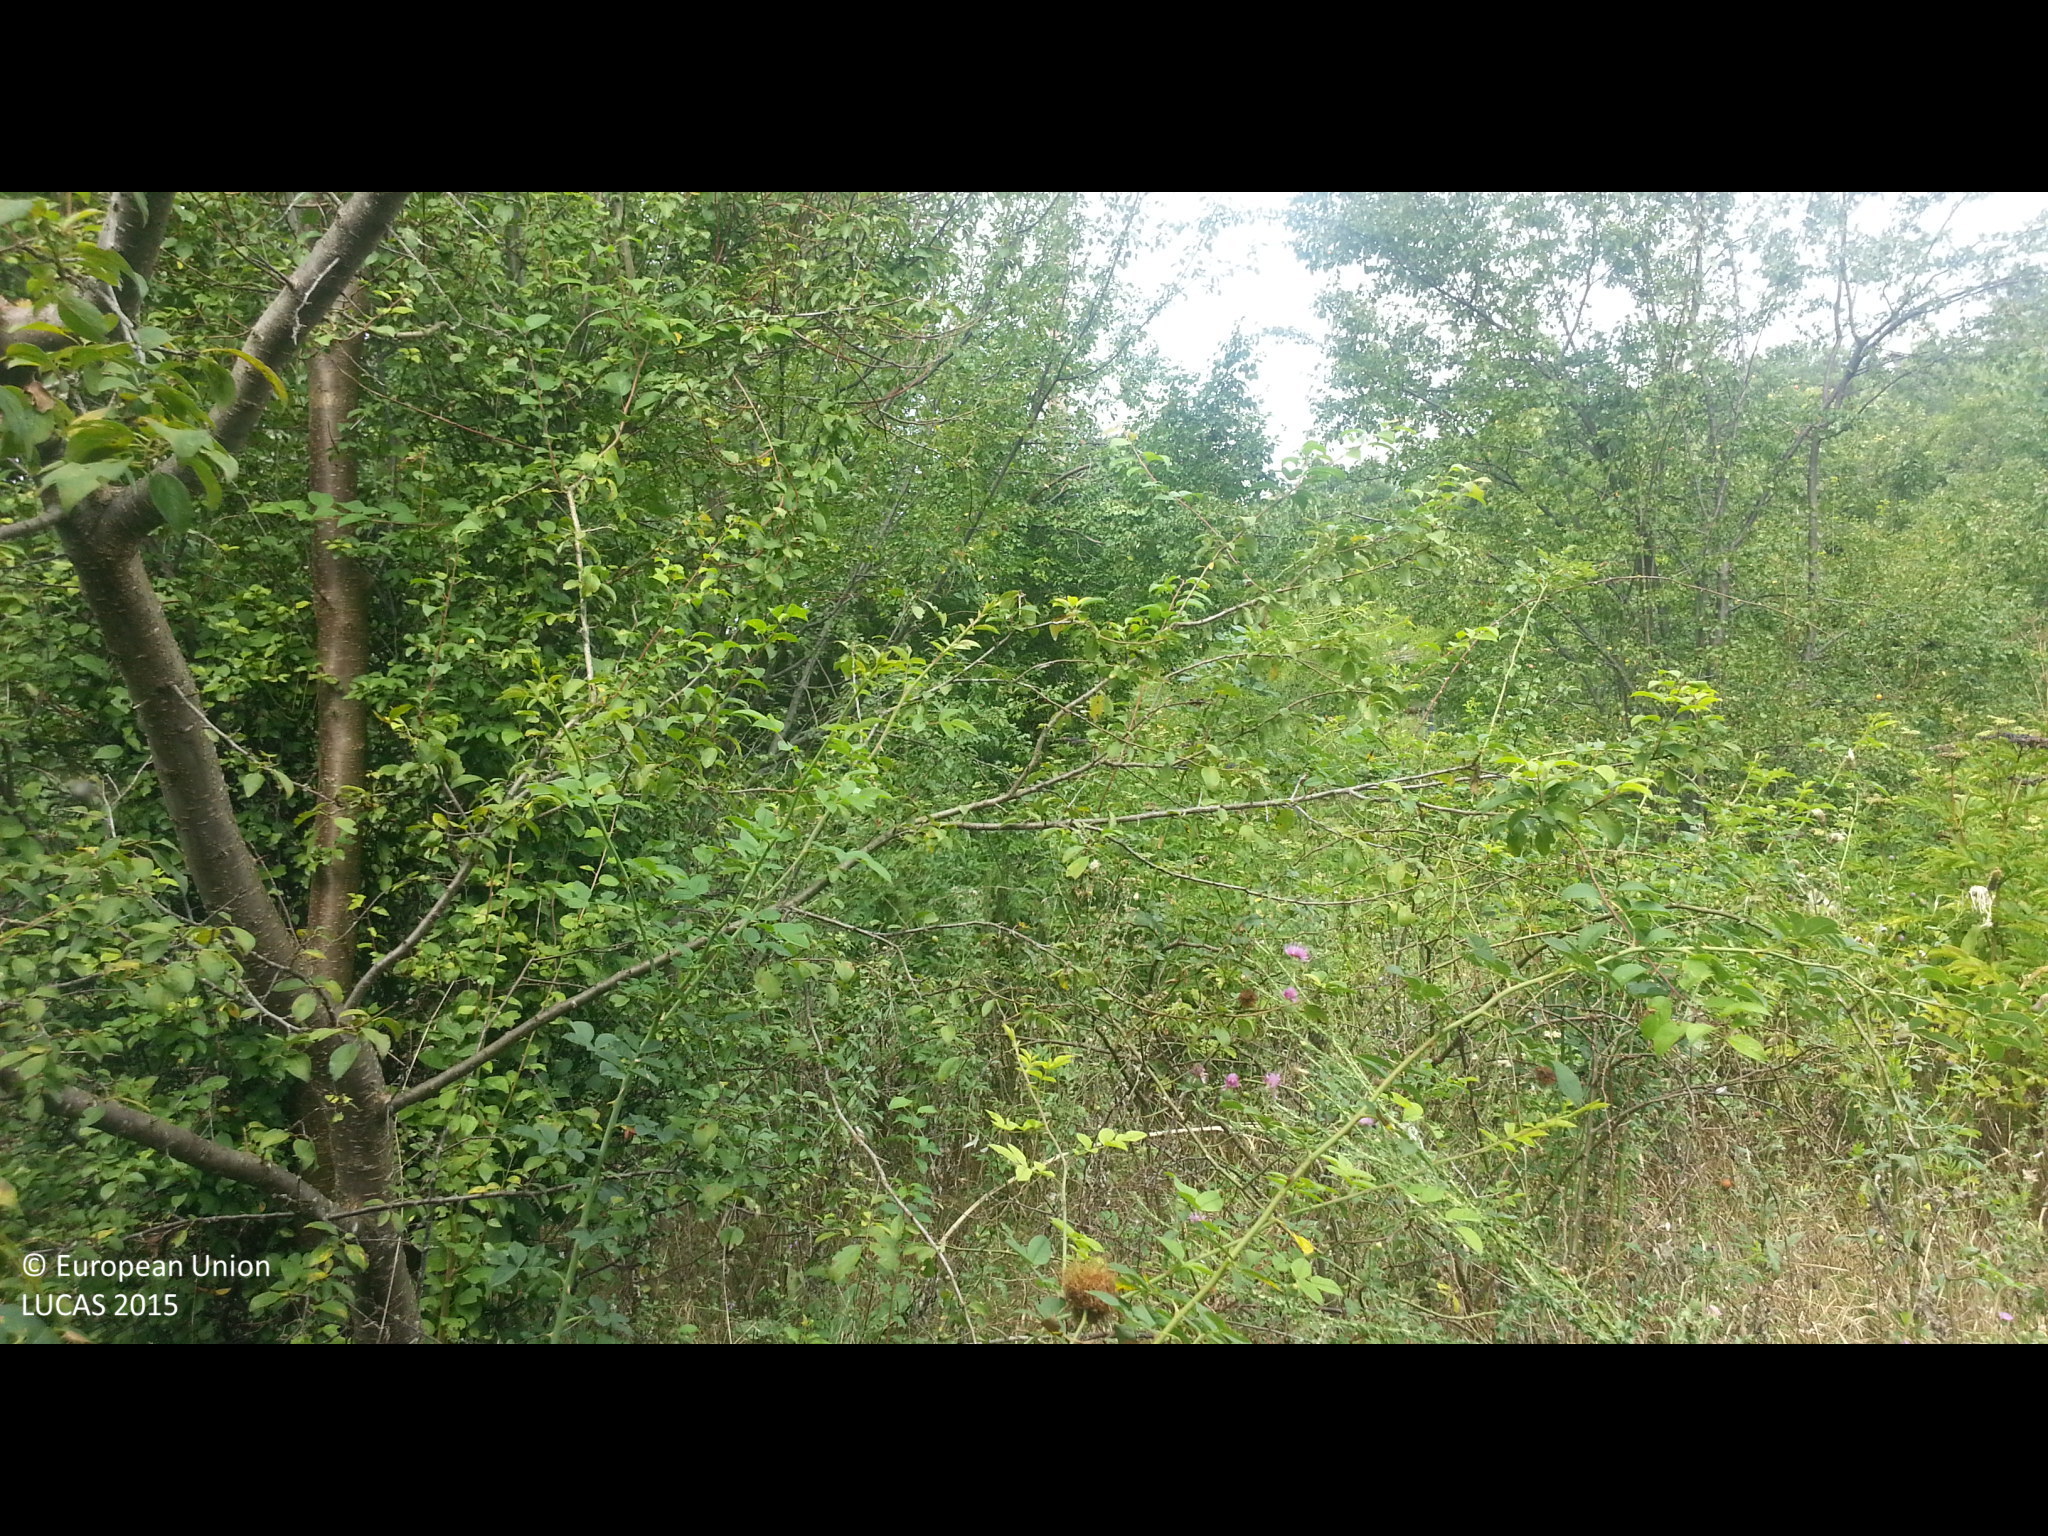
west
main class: Grassland
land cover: Grassland with sparse tree/shrub cover
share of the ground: > 75 %
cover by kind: herbaceous plants 85 %, shrubs 10 %, broadleaved forest trees 5 %
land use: Semi-natural and natural areas not in use
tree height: < 5 m
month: August
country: BG
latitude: 42.4020
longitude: 22.8180
